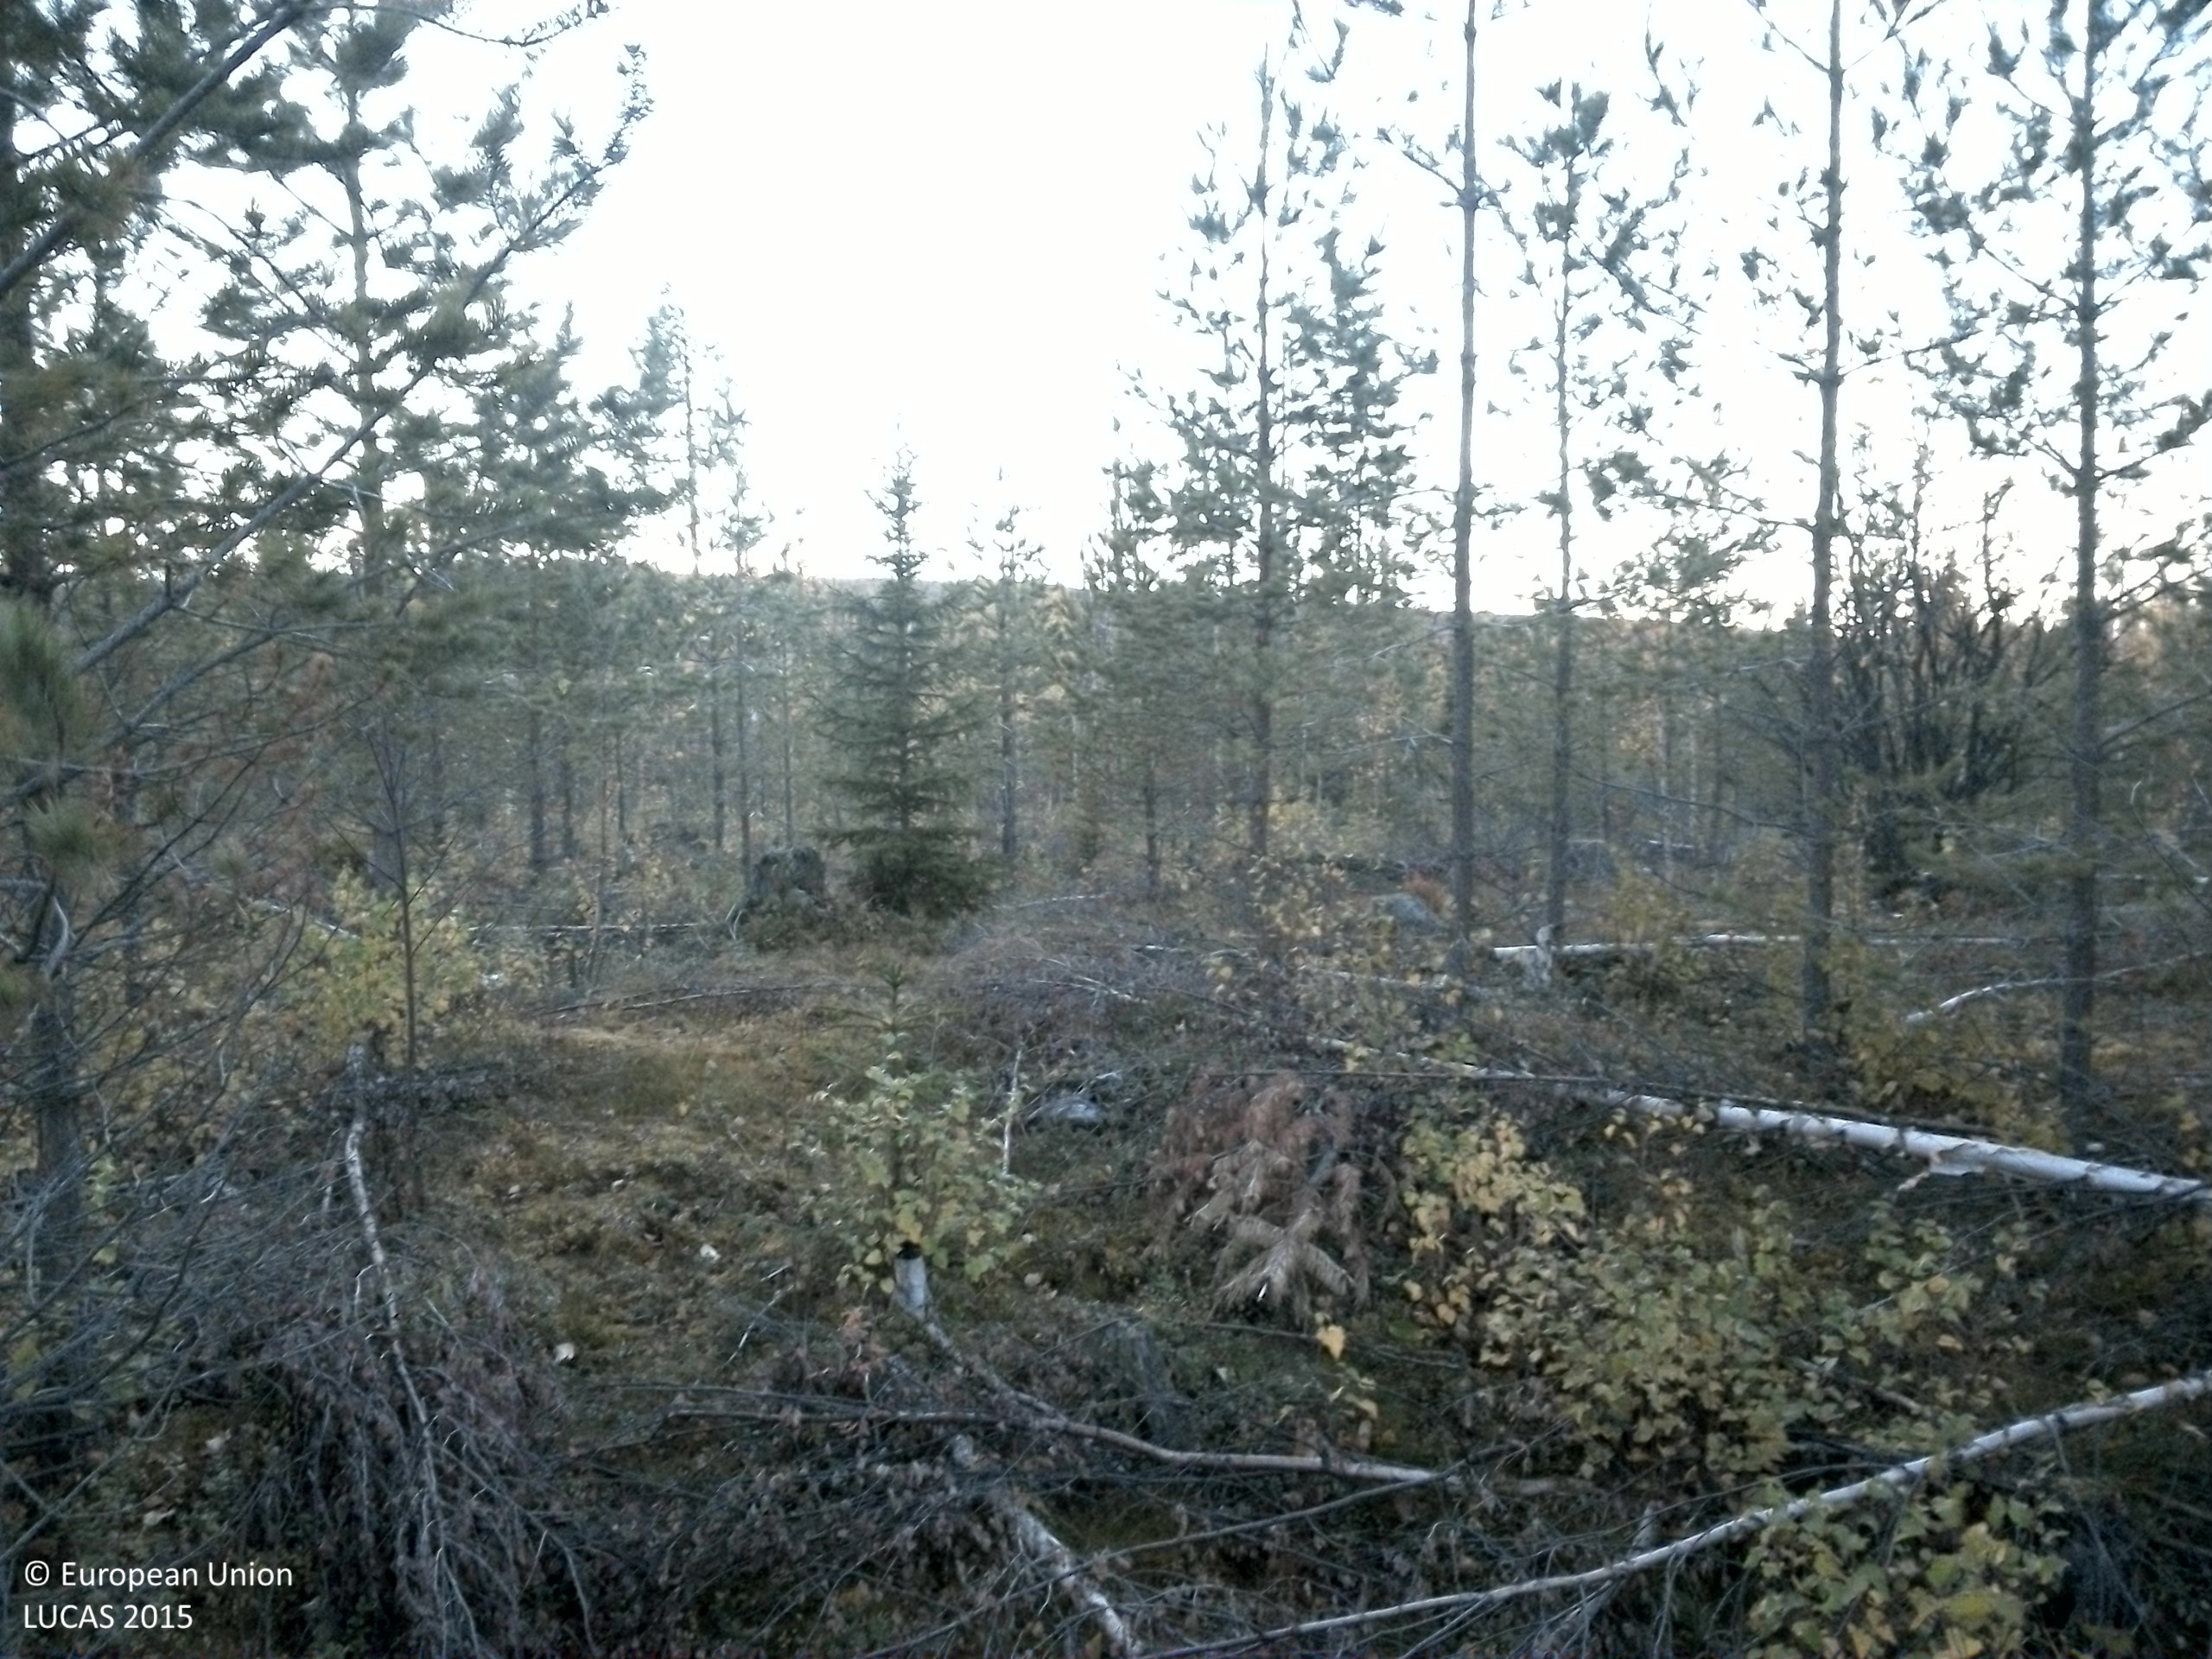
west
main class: Woodland
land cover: Pine dominated coniferous woodland
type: boreal forest
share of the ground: 25 - 50 %
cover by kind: coniferous forest trees 35 %, shrubs 30 %, lichens and mosses 15 %, broadleaved forest trees 10 %, herbaceous plants 10 %
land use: Forestry
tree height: < 5 m
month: October
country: SE
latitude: 64.3166
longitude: 16.1116
